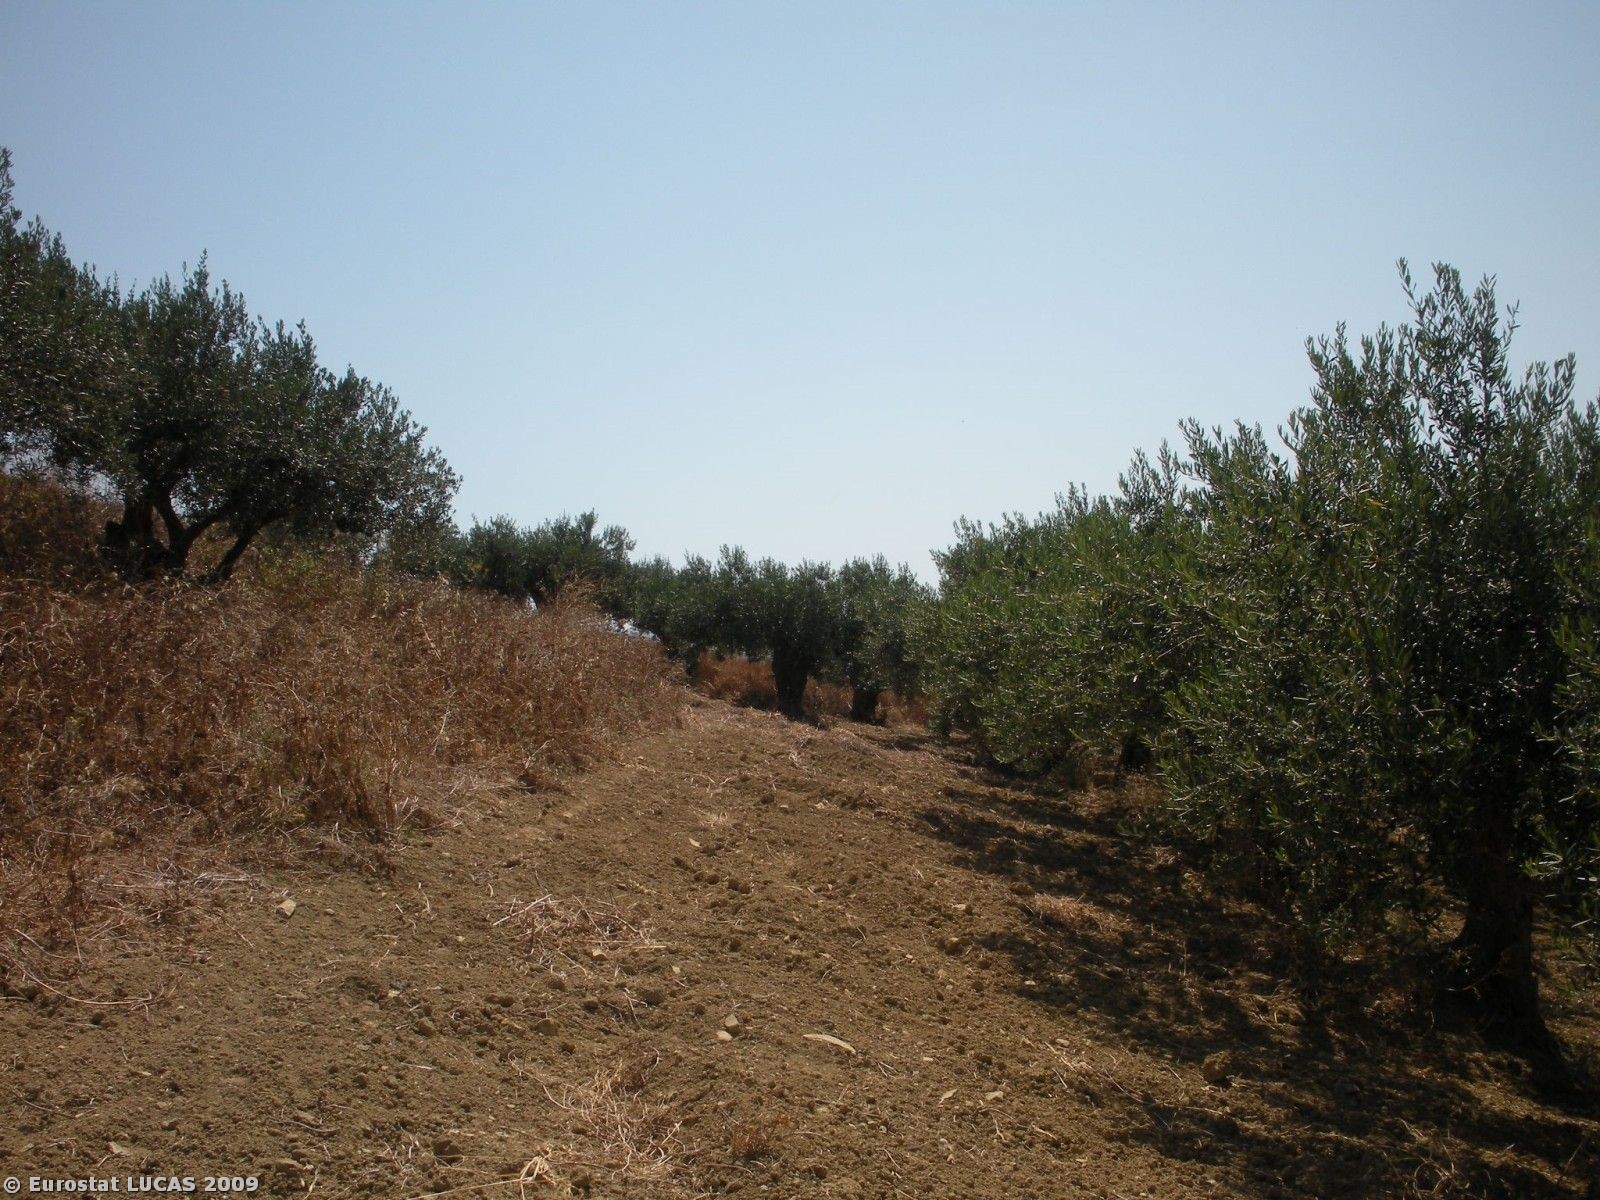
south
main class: Cropland
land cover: Olive groves
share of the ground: 50 - 75 %
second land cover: Spontaneously vegetated surfaces
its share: 50 - 75 %
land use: Agriculture (excluding fallow land and kitchen gardens)
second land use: Fallow land
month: July
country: IT
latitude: 37.9822
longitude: 12.6789
